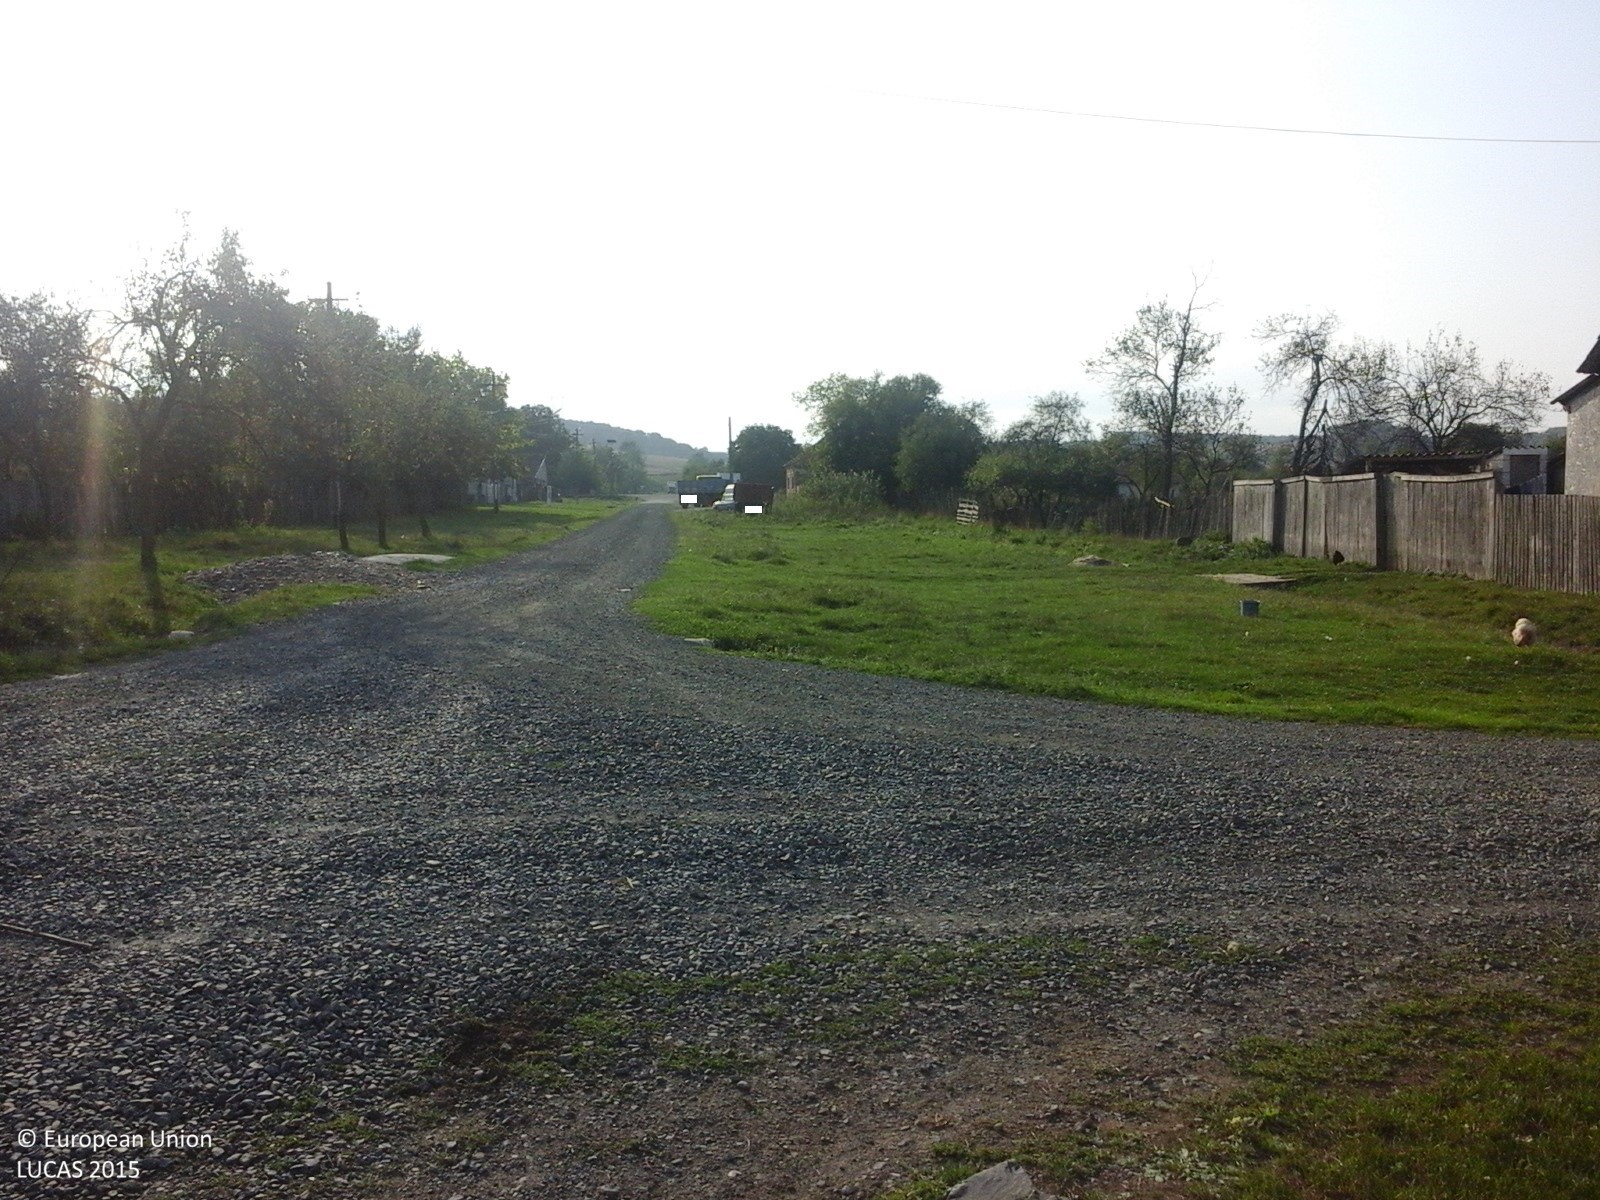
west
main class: Grassland
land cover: Grassland without tree/shrub cover
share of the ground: > 75 %
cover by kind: herbaceous plants 100 %
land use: Agriculture (excluding fallow land and kitchen gardens)
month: September
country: RO
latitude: 46.0141
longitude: 22.0408
